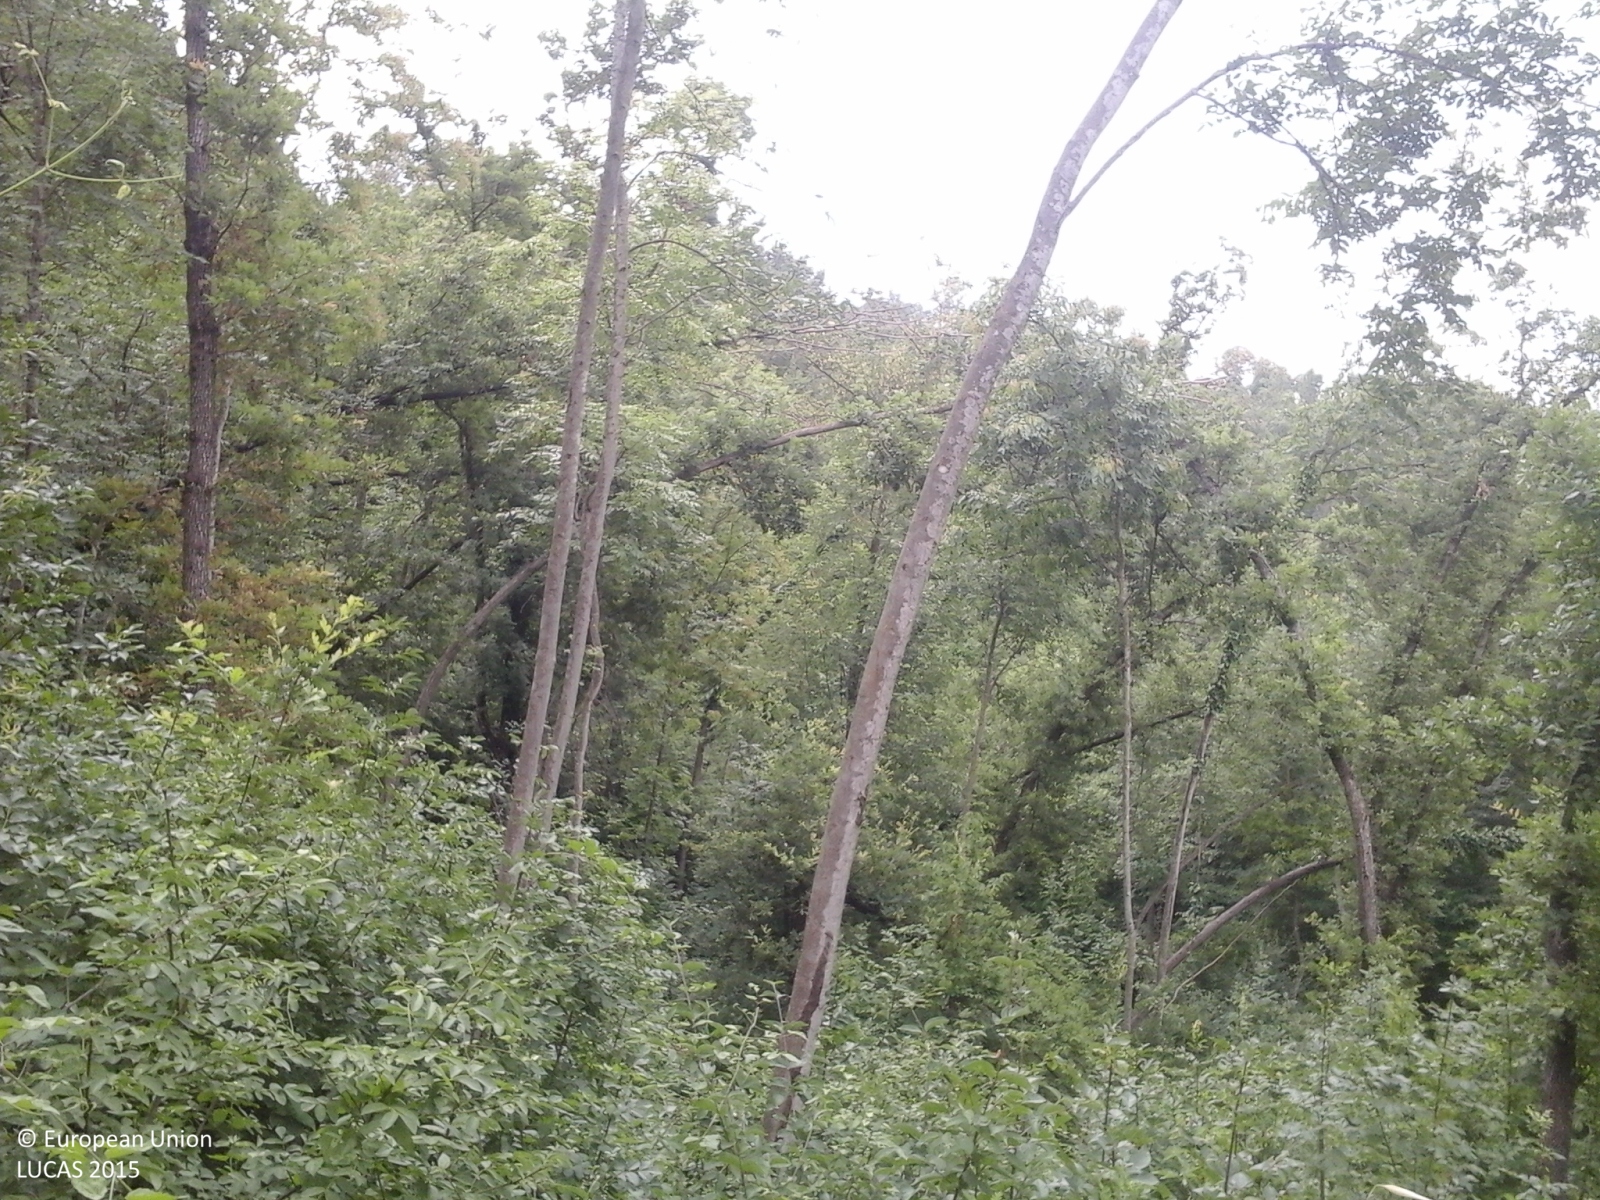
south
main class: Woodland
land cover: Broadleaved woodland
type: thermophilous deciduous forest
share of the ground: > 75 %
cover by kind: broadleaved forest trees 100 %
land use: Forestry
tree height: > 5 m
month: June
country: IT
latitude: 44.5667
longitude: 10.2387
